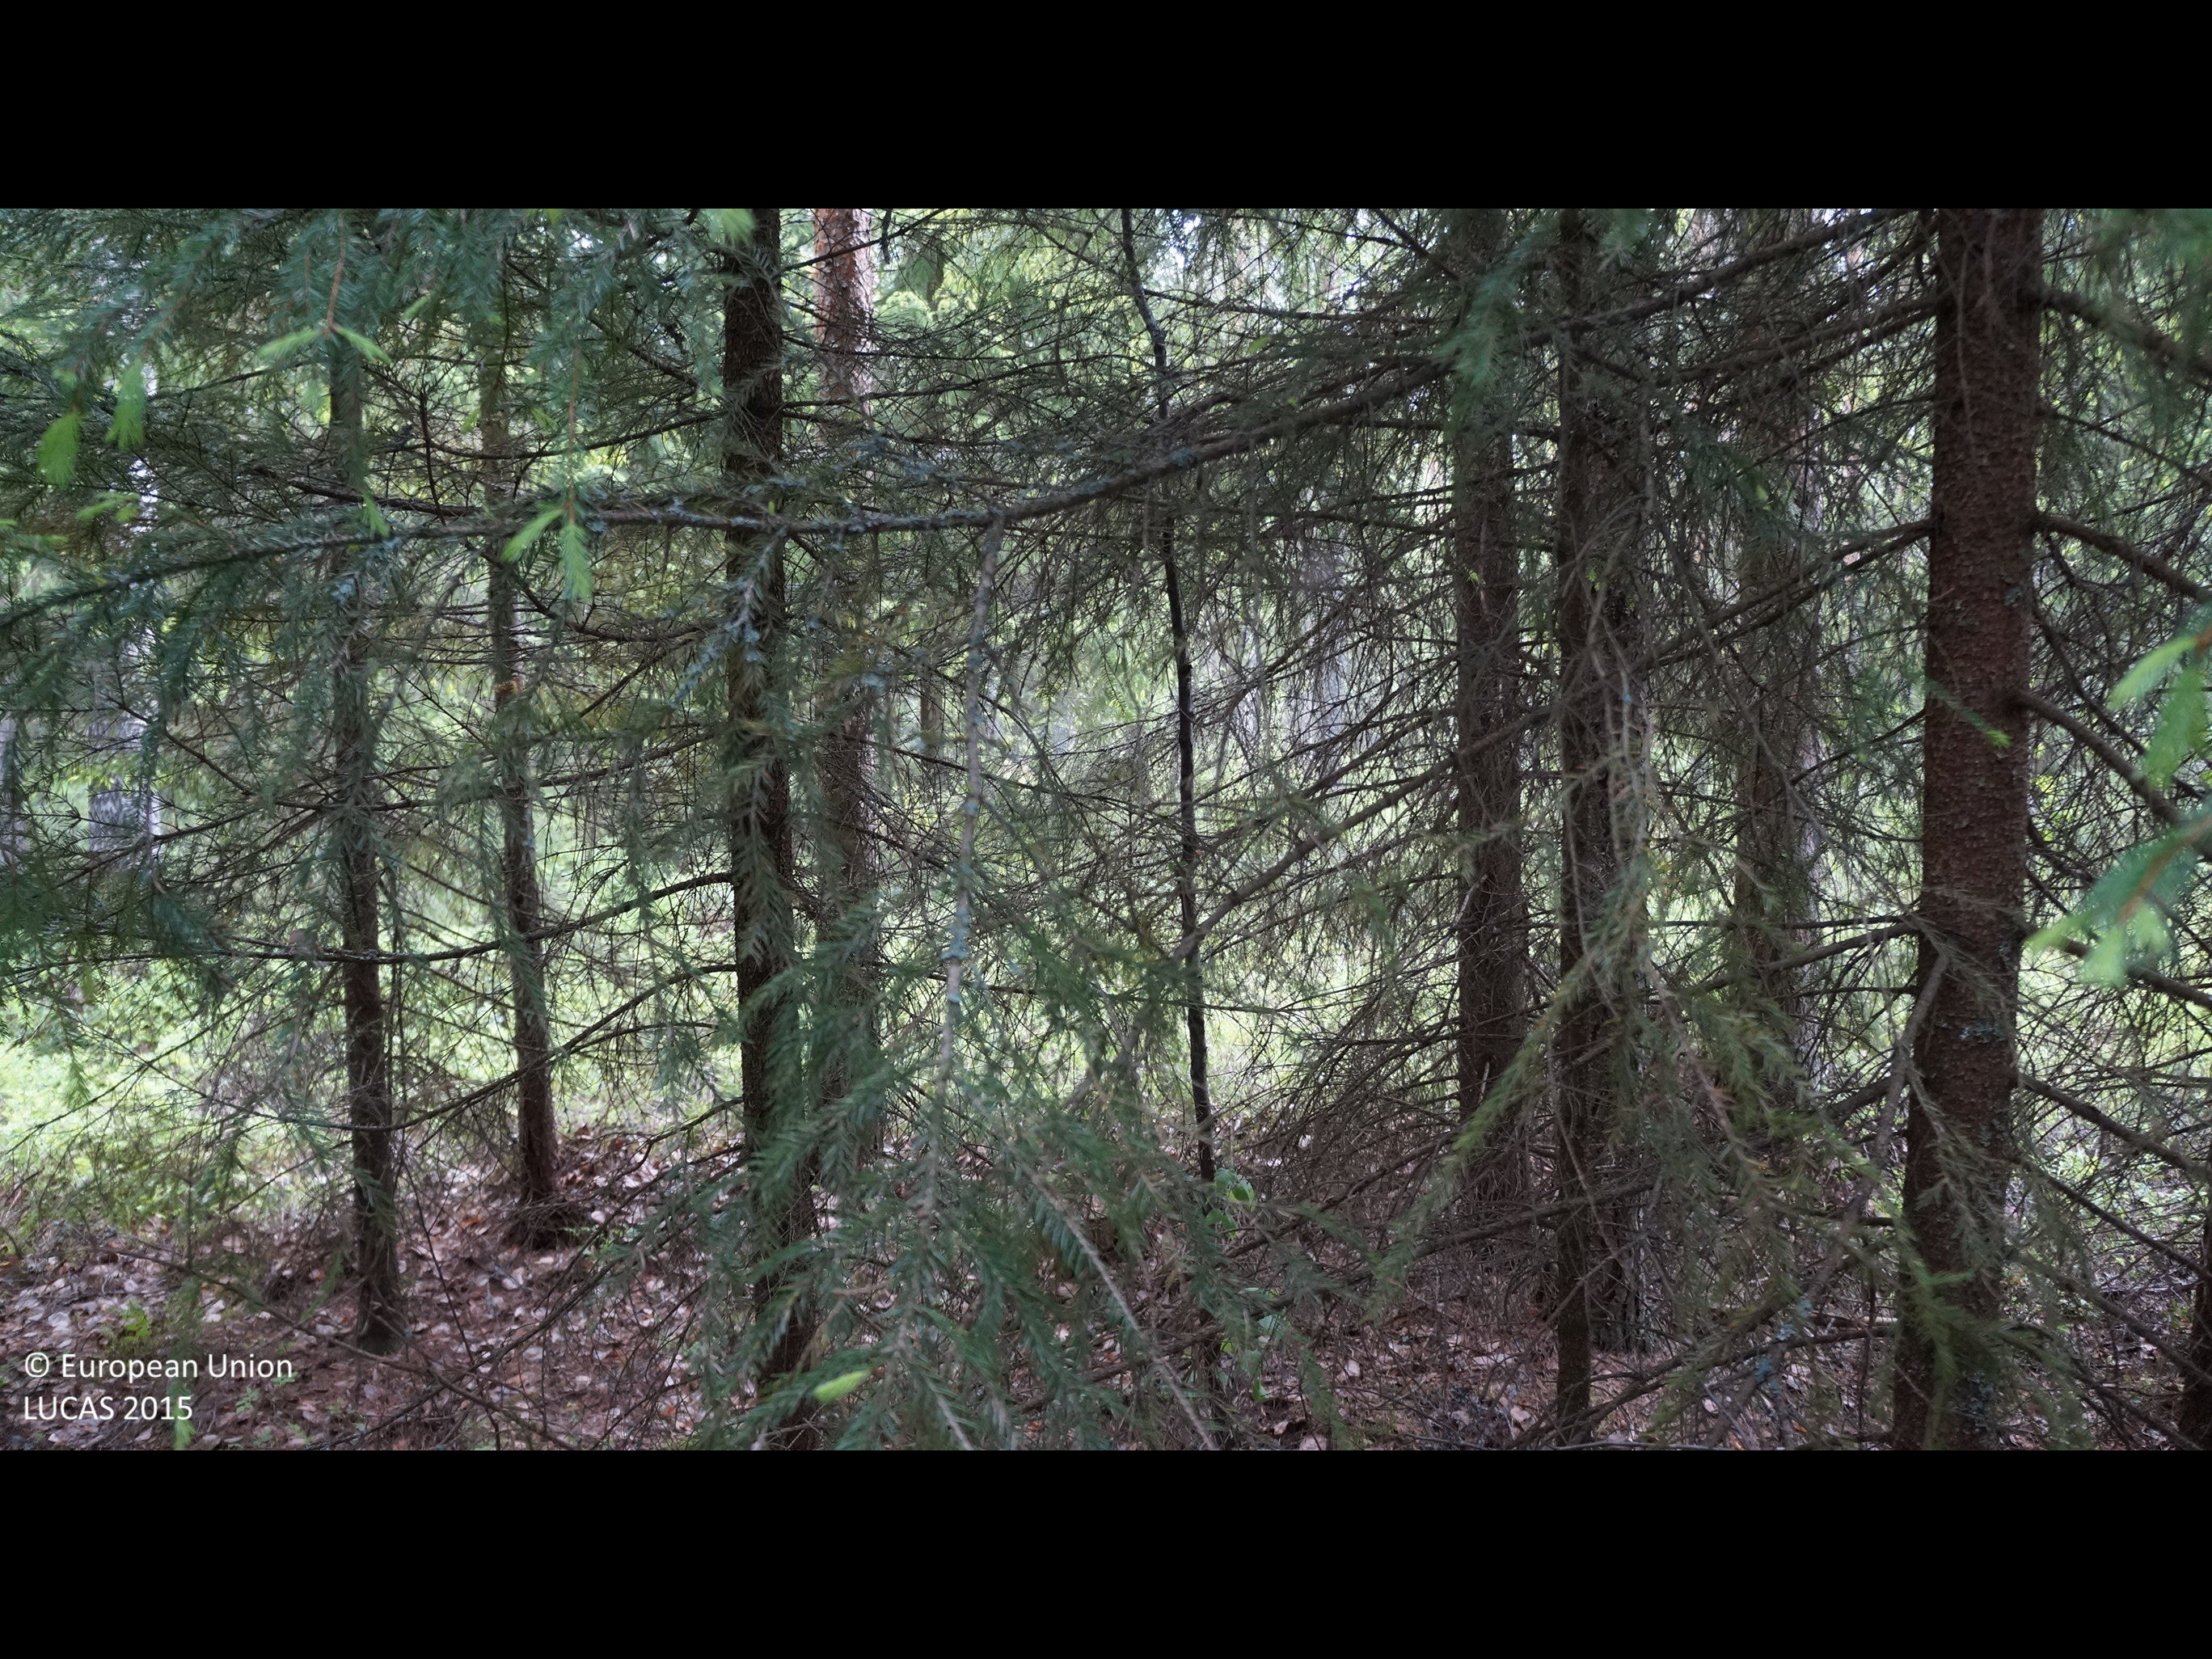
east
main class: Woodland
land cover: Other coniferous woodland
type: boreal forest
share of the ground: > 75 %
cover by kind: coniferous forest trees 70 %, shrubs 15 %, lichens and mosses 10 %, broadleaved forest trees 5 %
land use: Forestry
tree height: > 5 m
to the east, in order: Other coniferous woodland; Ditches and canals; Spruce dominated coniferous woodland; Pine dominated mixed woodland; Ditches and canals; Spruce dominated coniferous woodland; Ditches and canals; Spruce dominated coniferous woodland
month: June
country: FI
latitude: 64.1194
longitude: 25.2213
